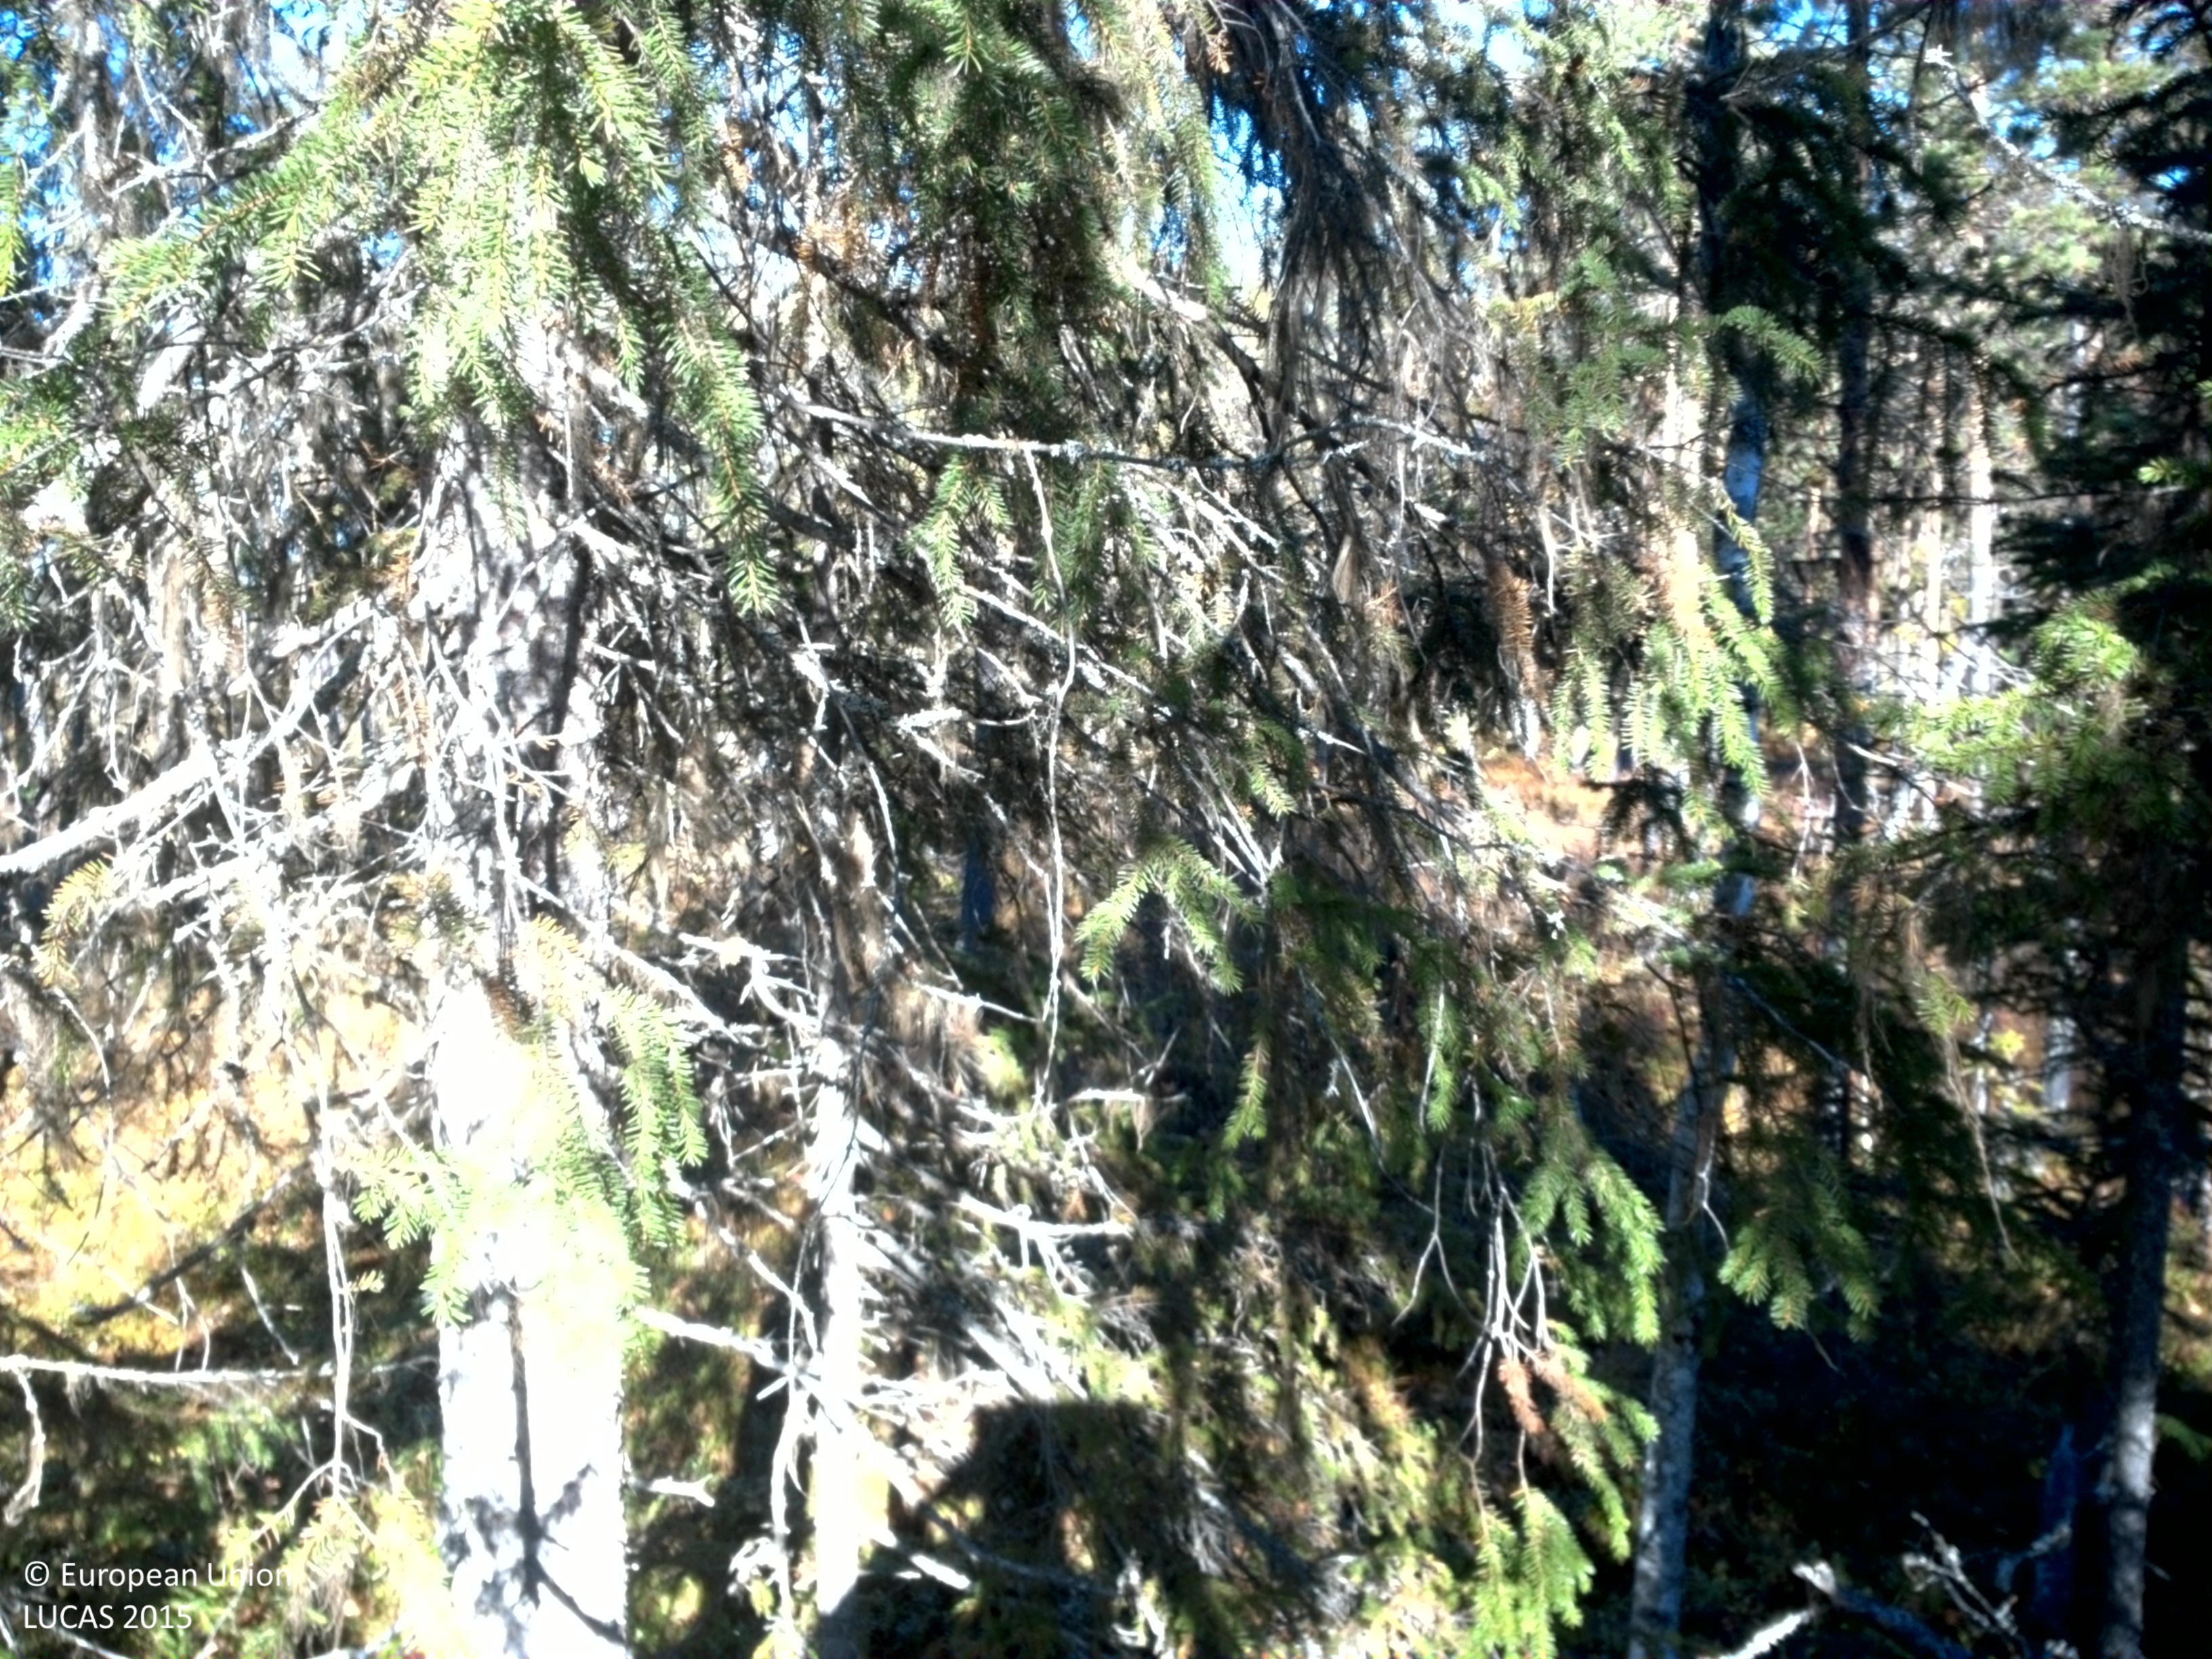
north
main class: Woodland
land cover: Spruce dominated mixed woodland
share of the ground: 25 - 50 %
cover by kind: shrubs 50 %, coniferous forest trees 20 %, broadleaved forest trees 15 %, lichens and mosses 10 %, herbaceous plants 5 %
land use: Forestry
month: September
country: SE
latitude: 64.9681
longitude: 17.8221
